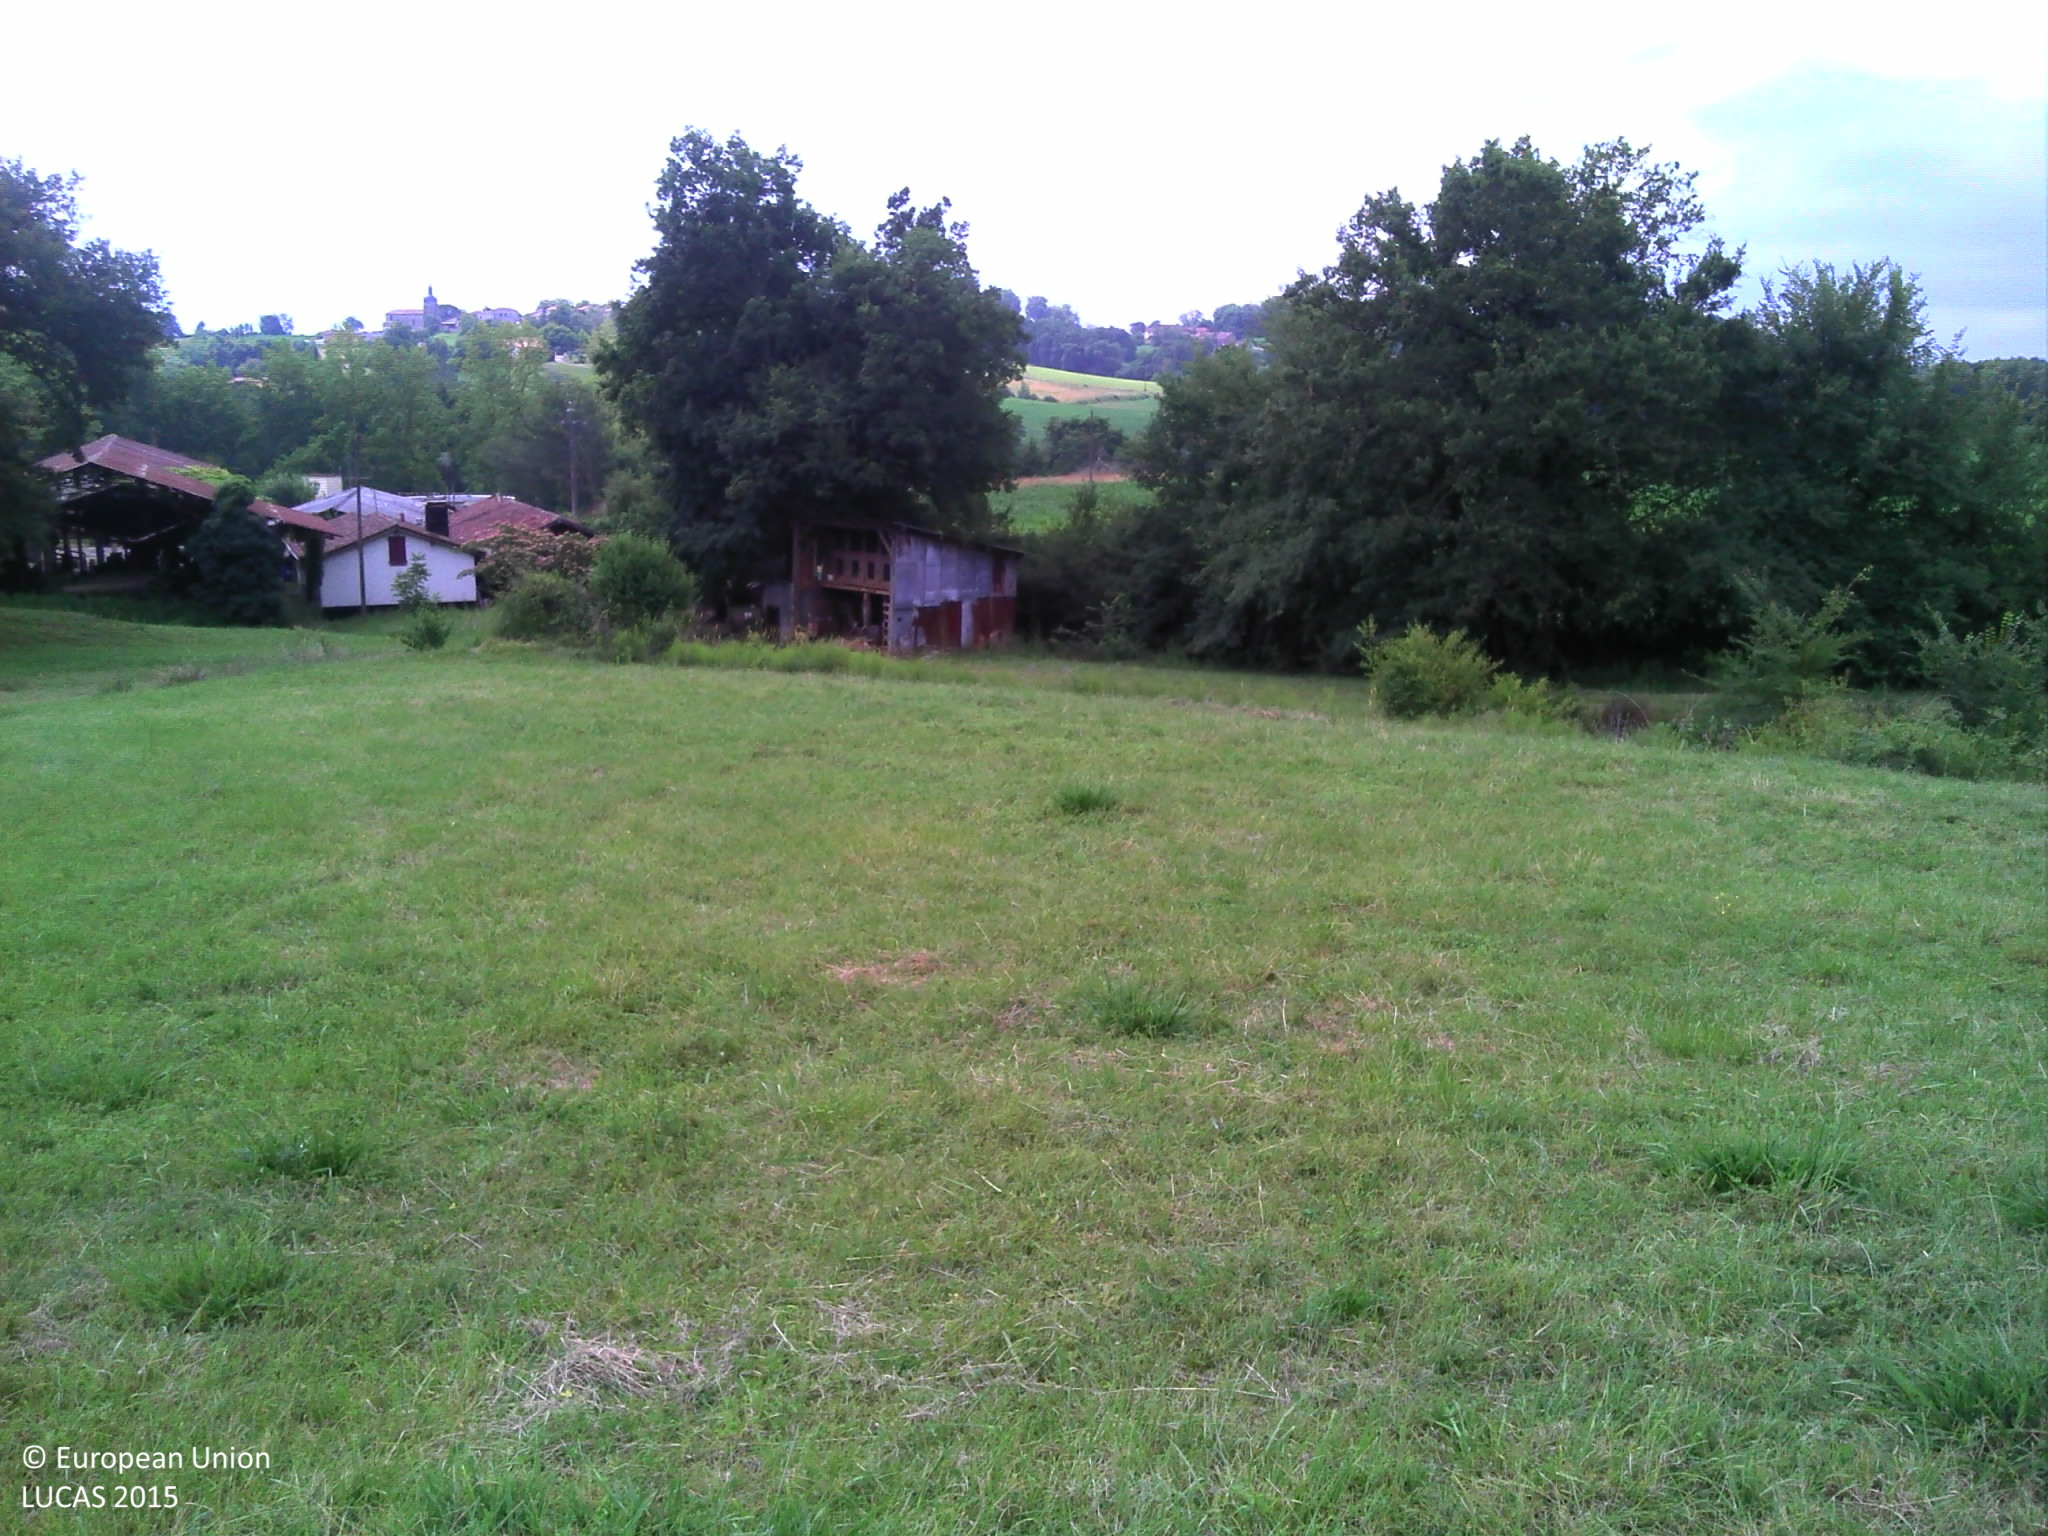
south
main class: Grassland
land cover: Grassland without tree/shrub cover
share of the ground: > 75 %
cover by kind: herbaceous plants 100 %
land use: Agriculture (excluding fallow land and kitchen gardens)
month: July
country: FR
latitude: 43.6591
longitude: -0.7885
